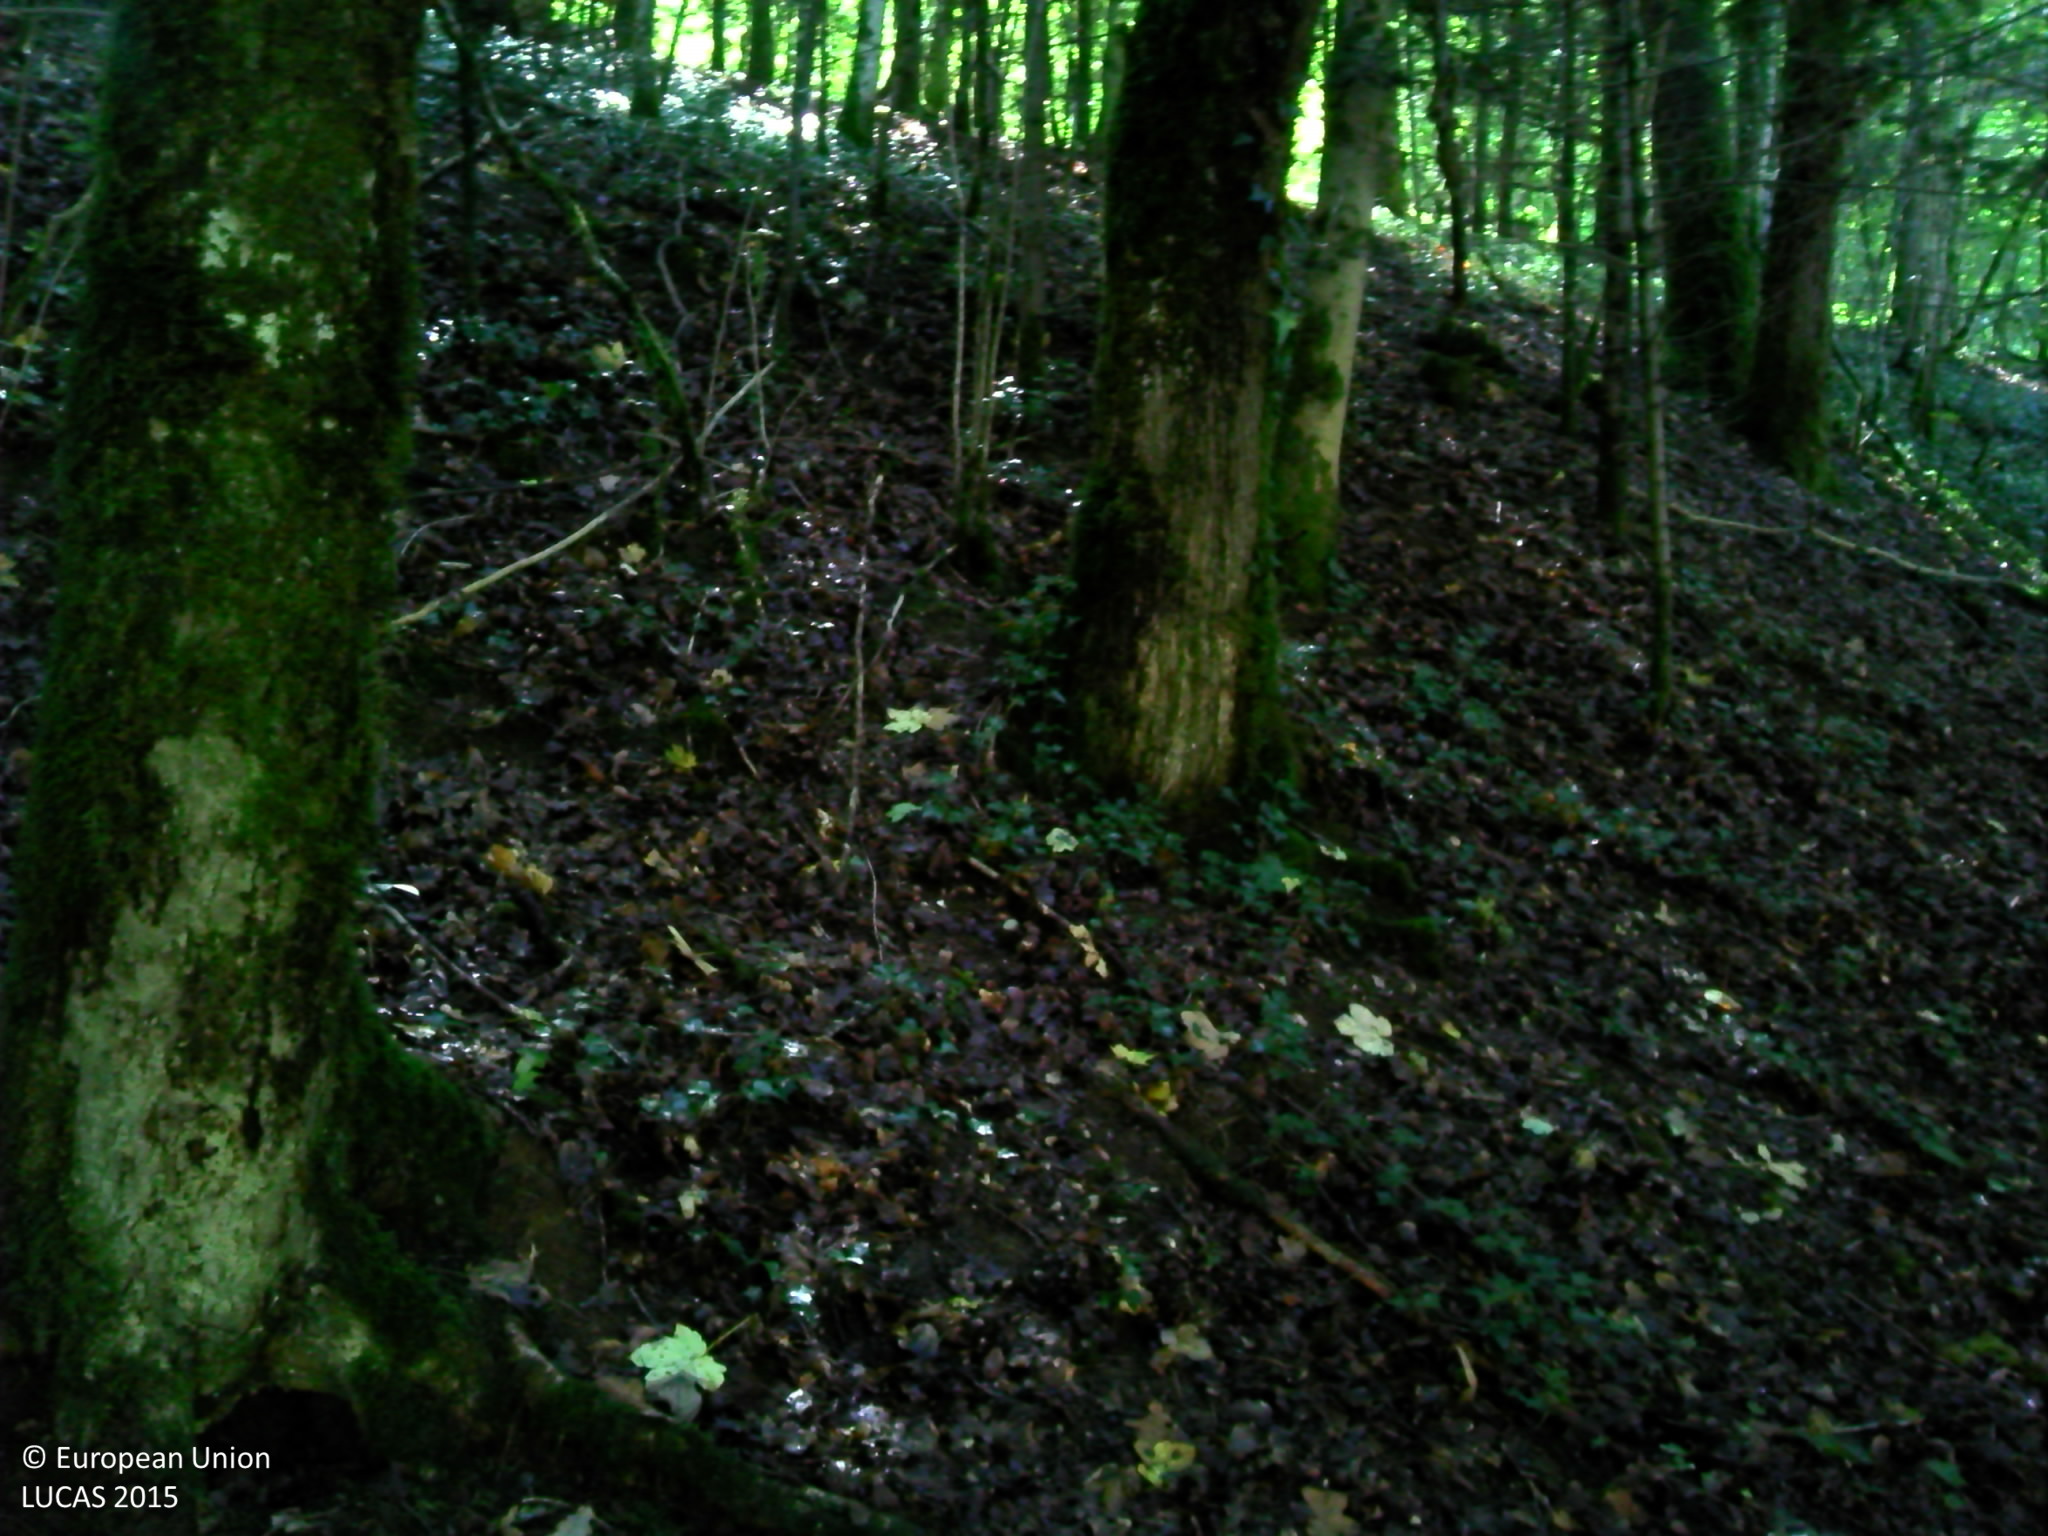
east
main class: Woodland
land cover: Broadleaved woodland
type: floodplain forest
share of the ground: > 75 %
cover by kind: broadleaved forest trees 90 %, herbaceous plants 5 %, unconsolidated bare surface 5 %
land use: Forestry
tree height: > 5 m
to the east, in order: Broadleaved woodland; Fences; Spruce dominated coniferous woodland; Tracks; Spruce dominated coniferous woodland; Fences; Grassland without tree/shrub cover; Fences; Broadleaved woodland
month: September
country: FR
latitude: 47.1099
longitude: 6.1144
